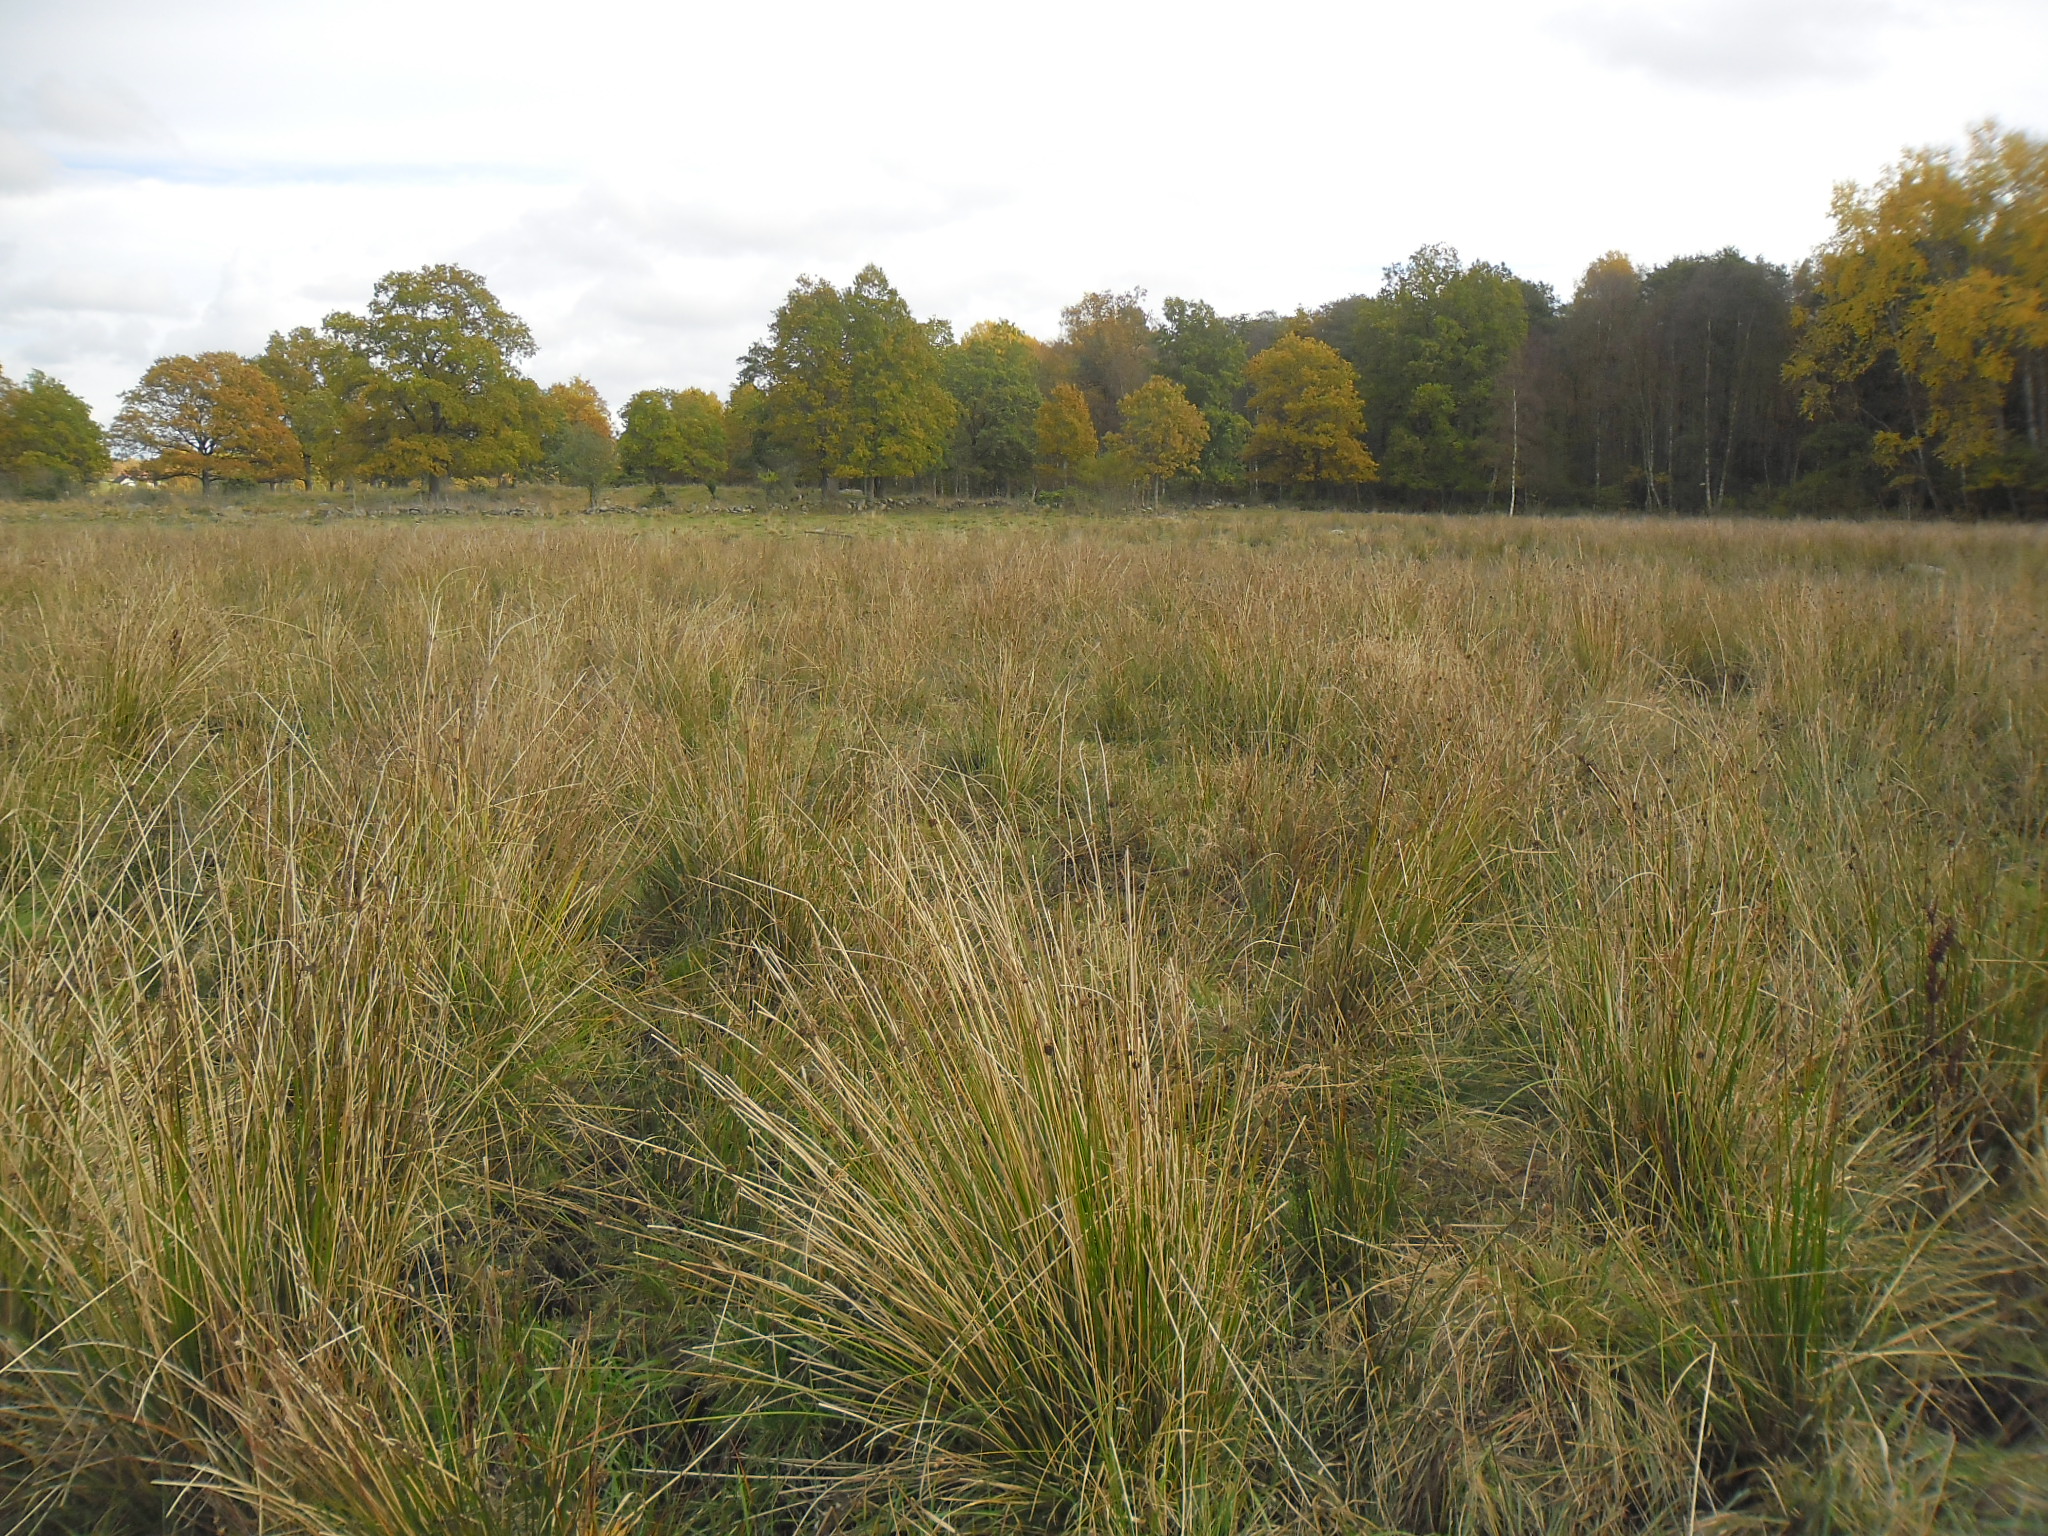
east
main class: Grassland
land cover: Grassland without tree/shrub cover
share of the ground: > 75 %
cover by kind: herbaceous plants 100 %
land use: Agriculture (excluding fallow land and kitchen gardens)
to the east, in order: Grassland without tree/shrub cover; Dry stone walls; Broadleaved woodland; Dry stone walls; Broadleaved woodland; Dry stone walls; Grassland without tree/shrub cover
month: October
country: SE
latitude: 56.0254
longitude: 13.7362
